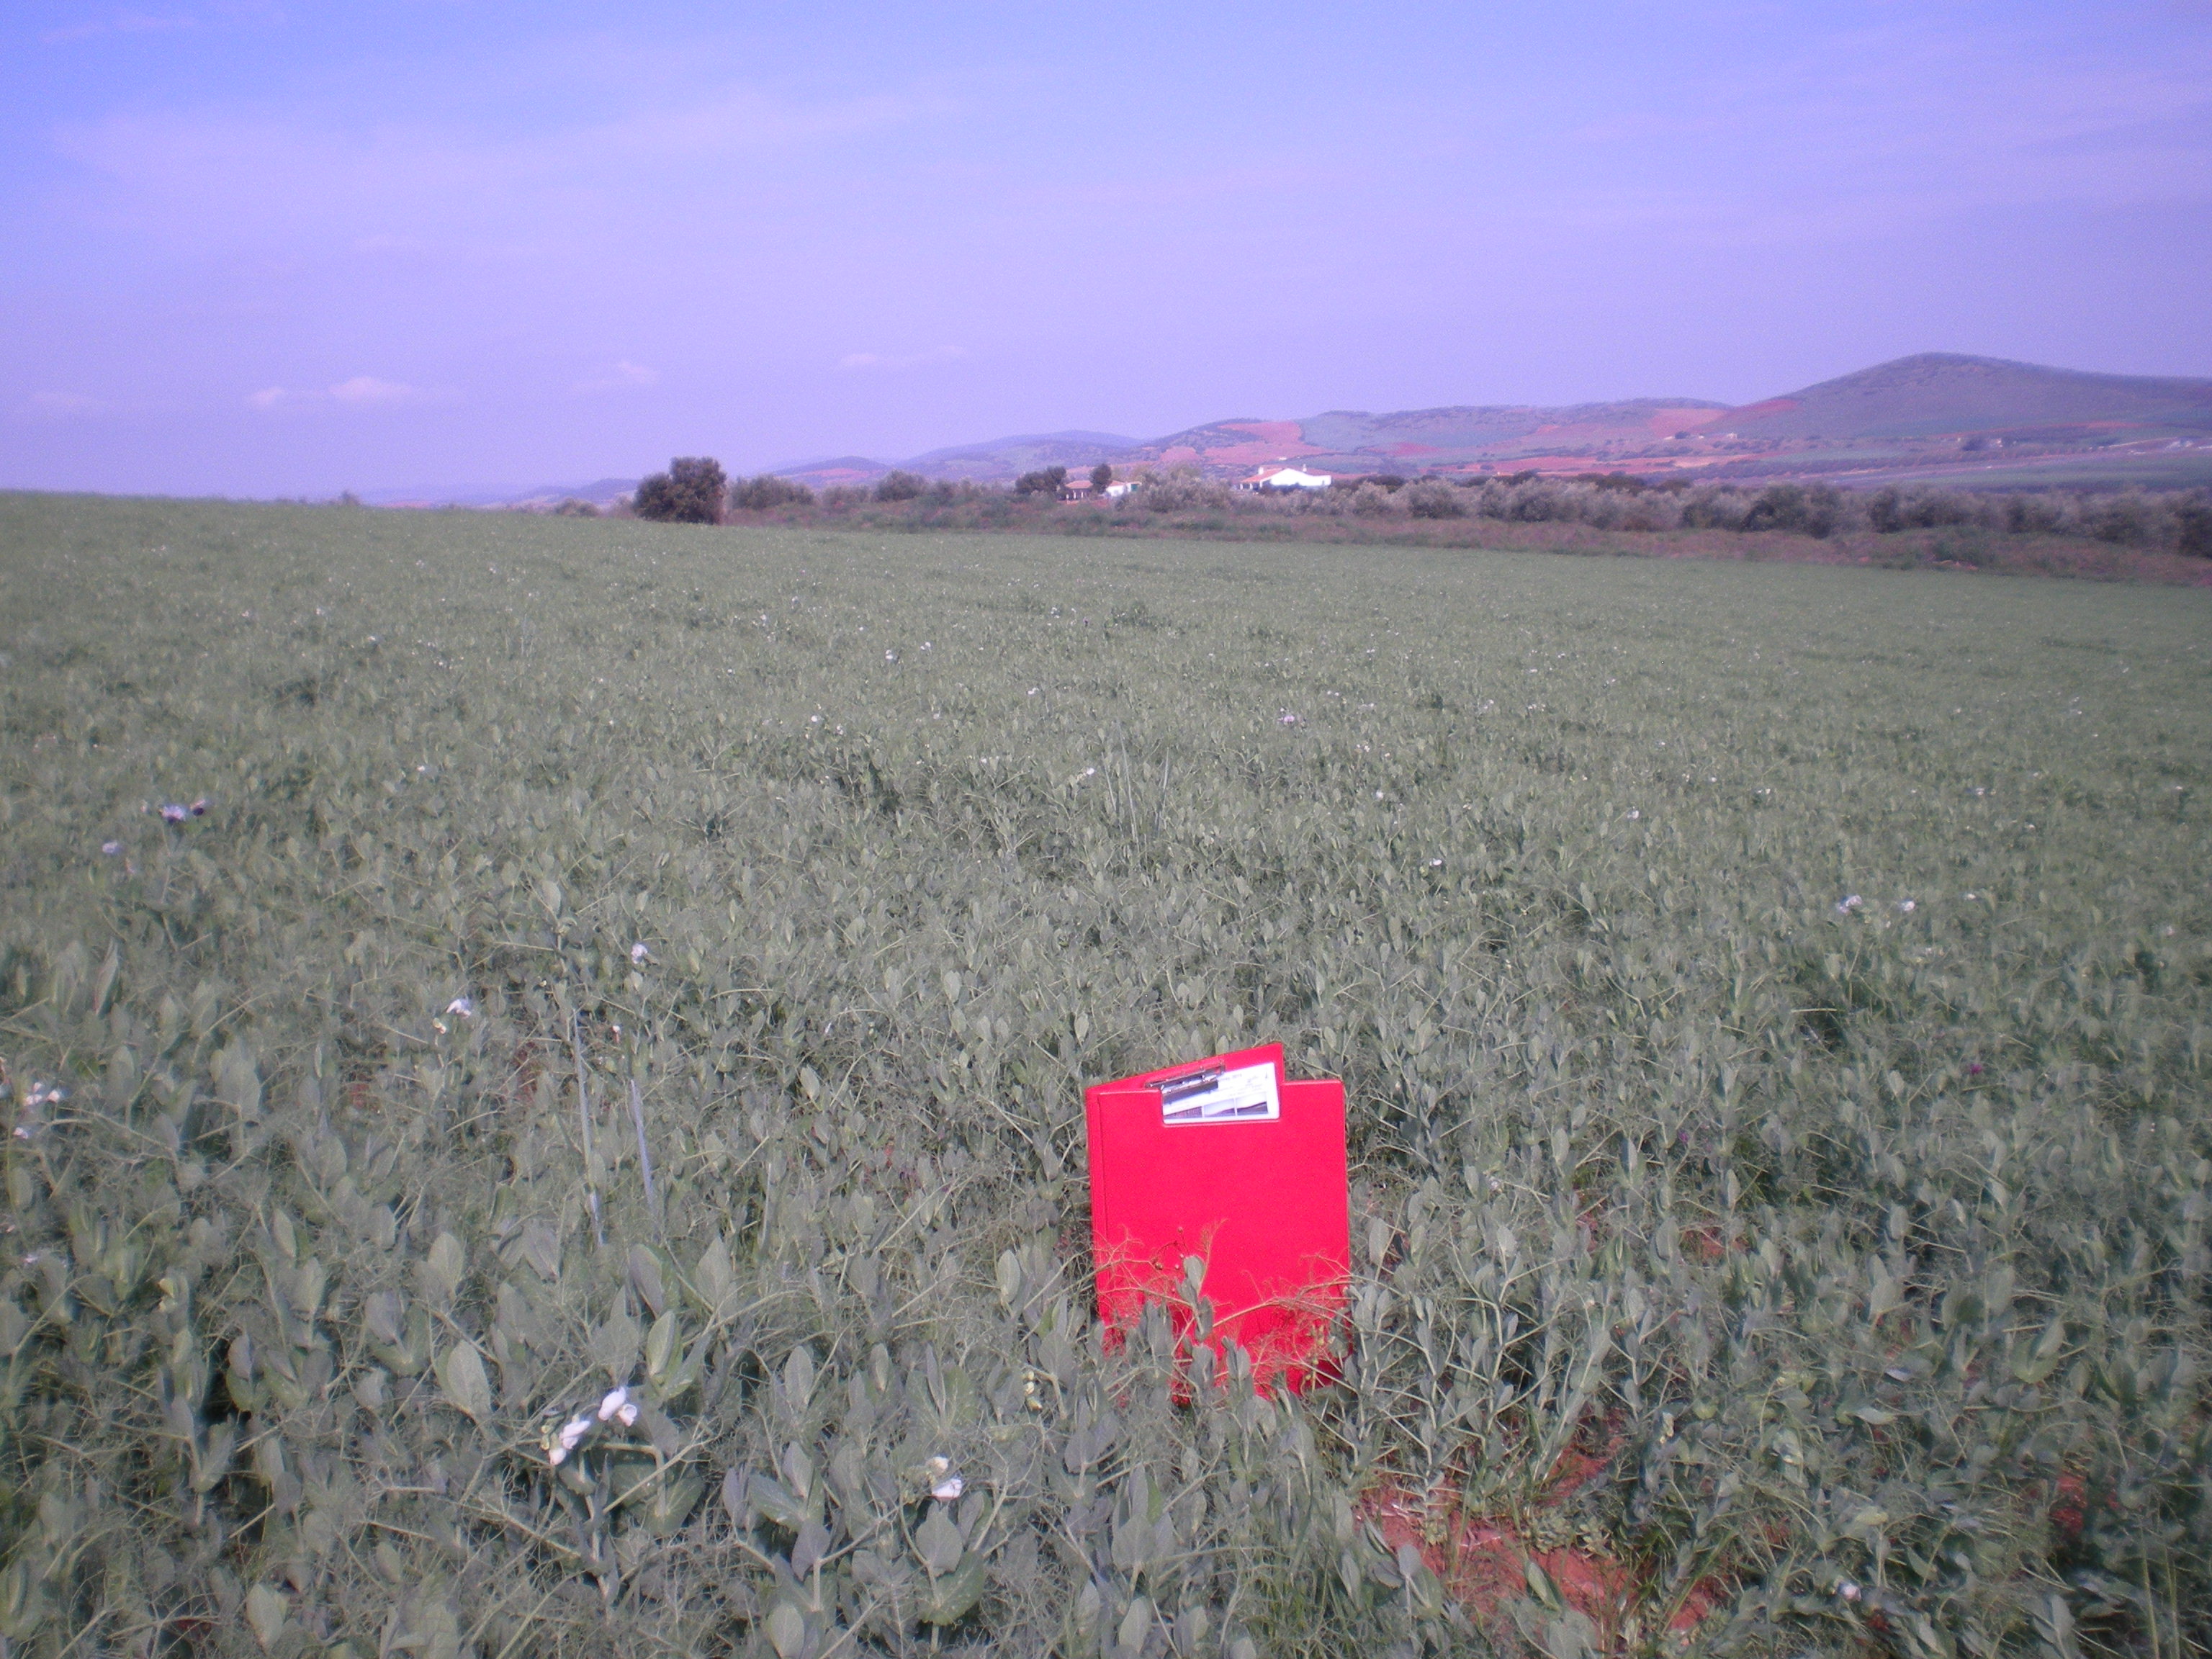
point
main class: Cropland
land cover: Dry pulses
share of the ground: > 75 %
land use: Agriculture (excluding fallow land and kitchen gardens)
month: April
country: ES
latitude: 38.5849
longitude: -3.4521
